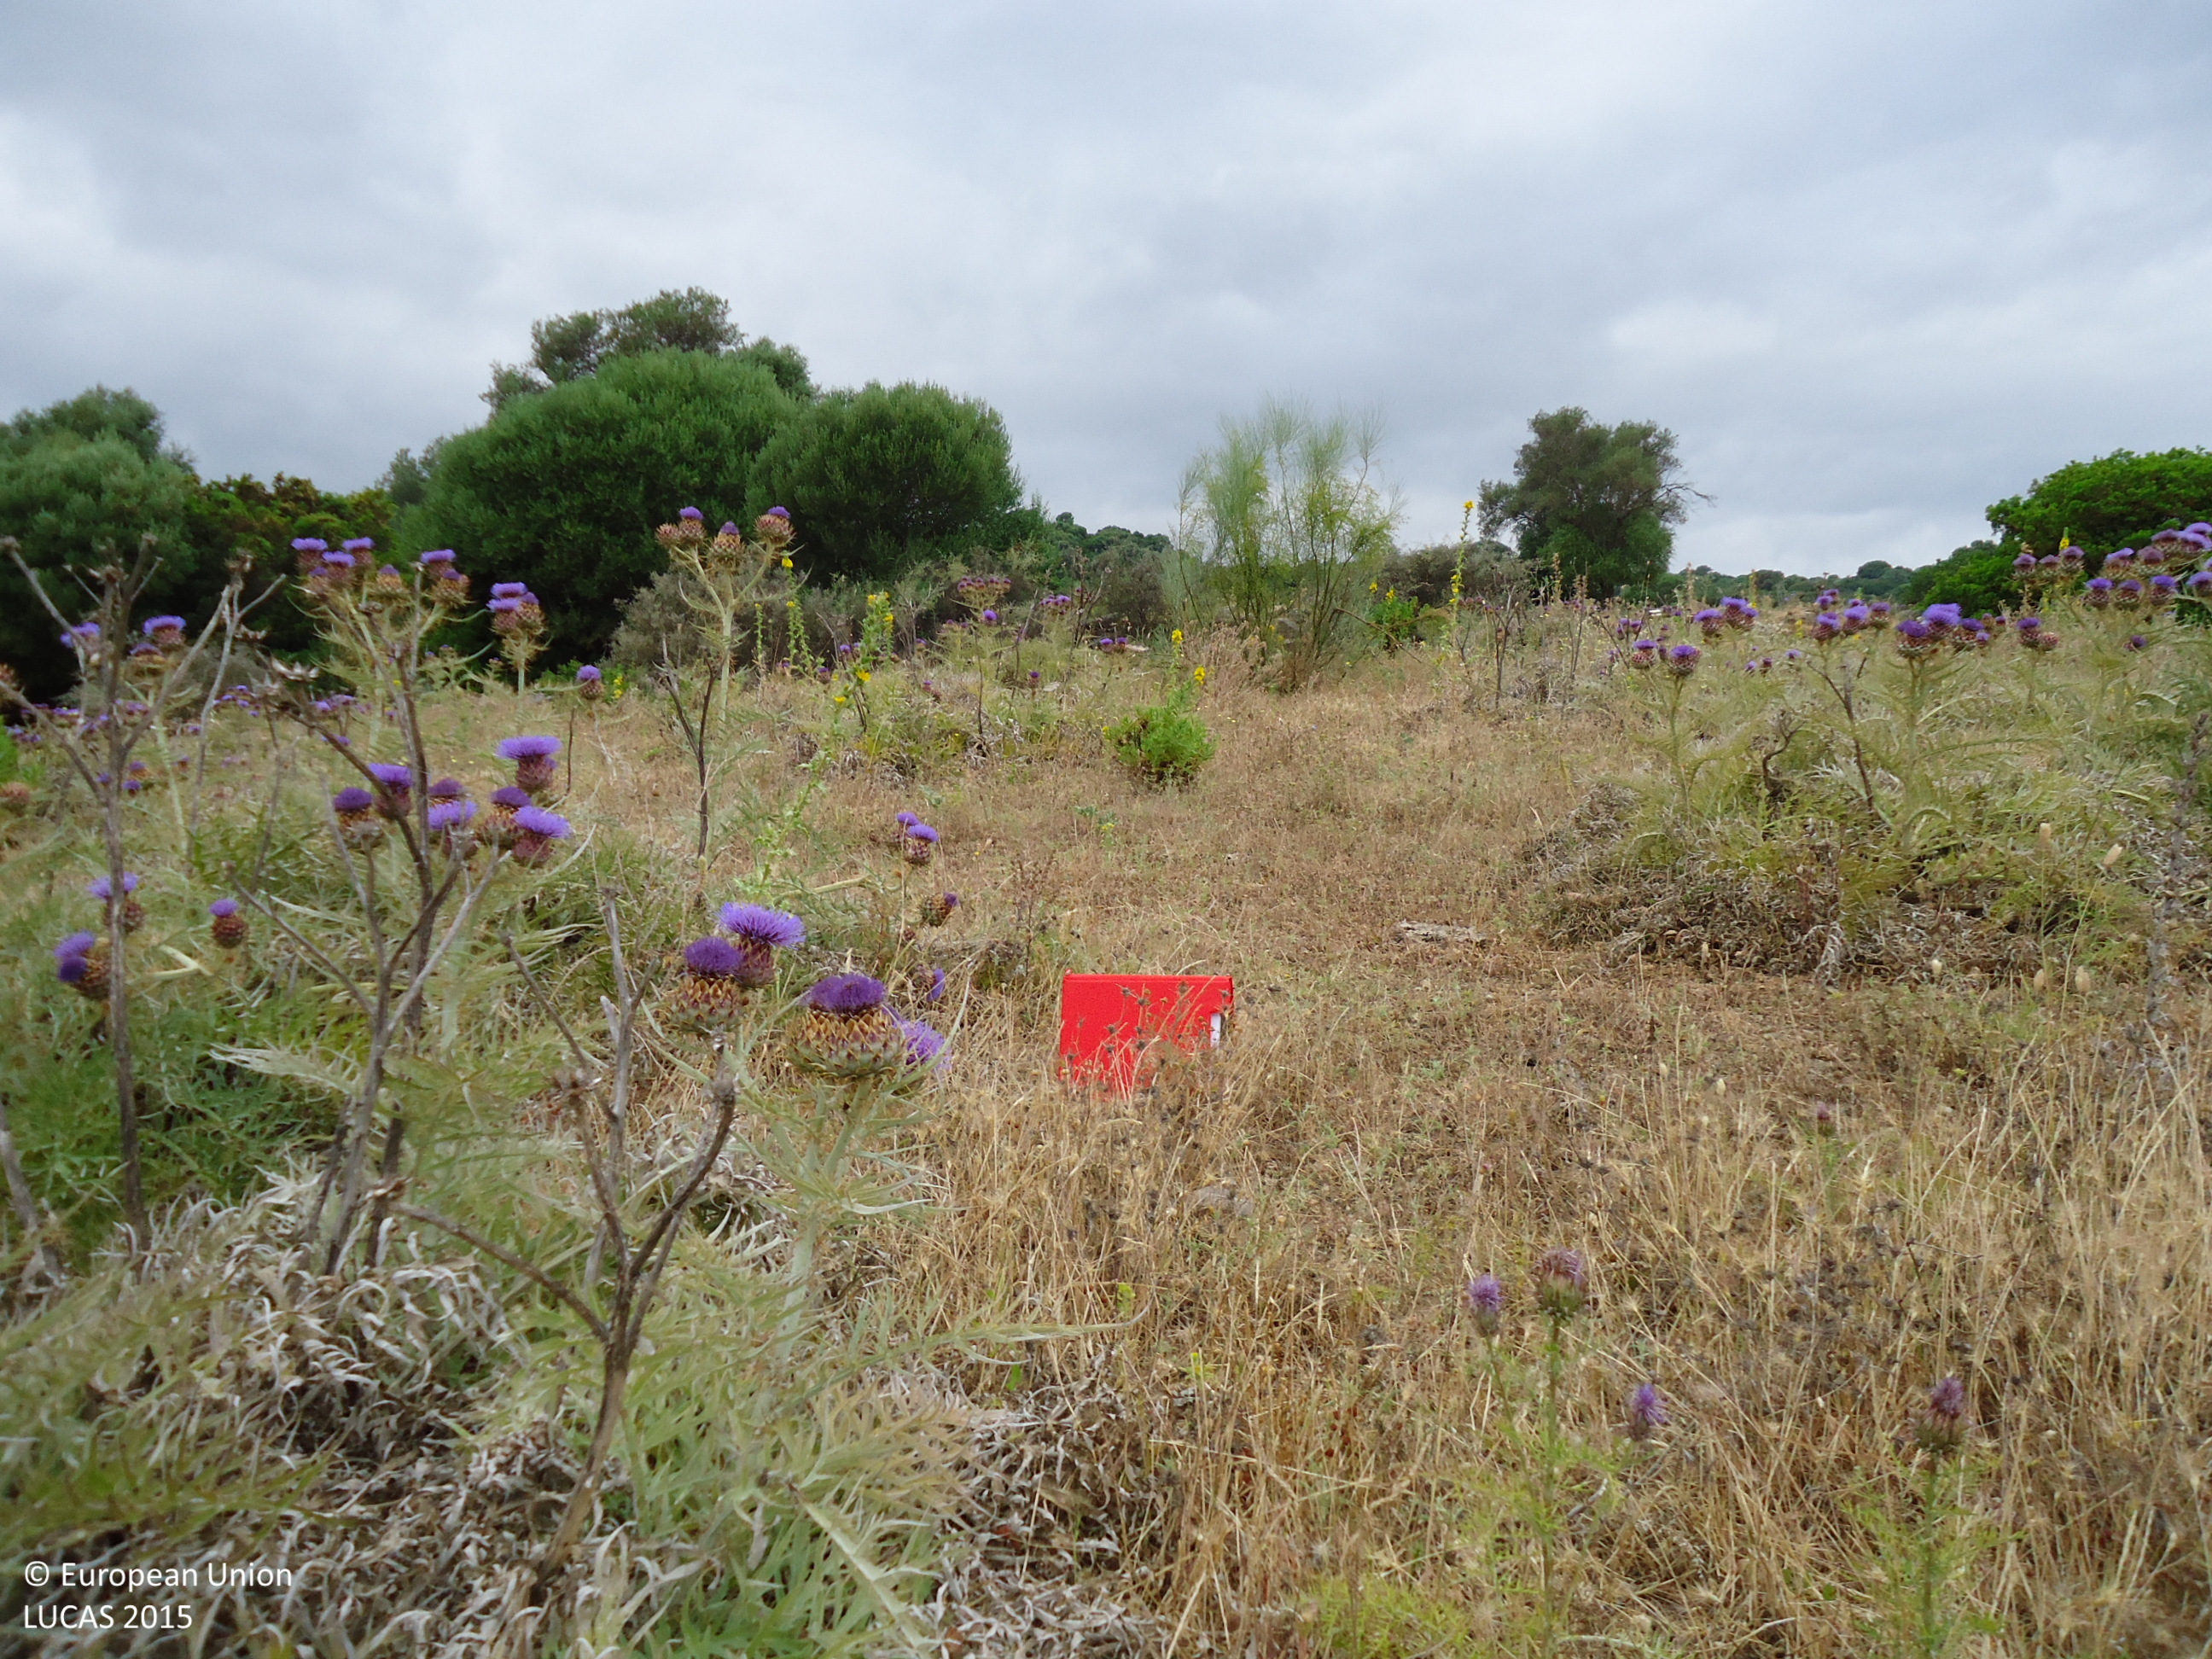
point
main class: Grassland
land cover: Grassland without tree/shrub cover
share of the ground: > 75 %
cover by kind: herbaceous plants 100 %
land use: Agriculture (excluding fallow land and kitchen gardens)
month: June
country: ES
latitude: 36.4582
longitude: -5.3388
